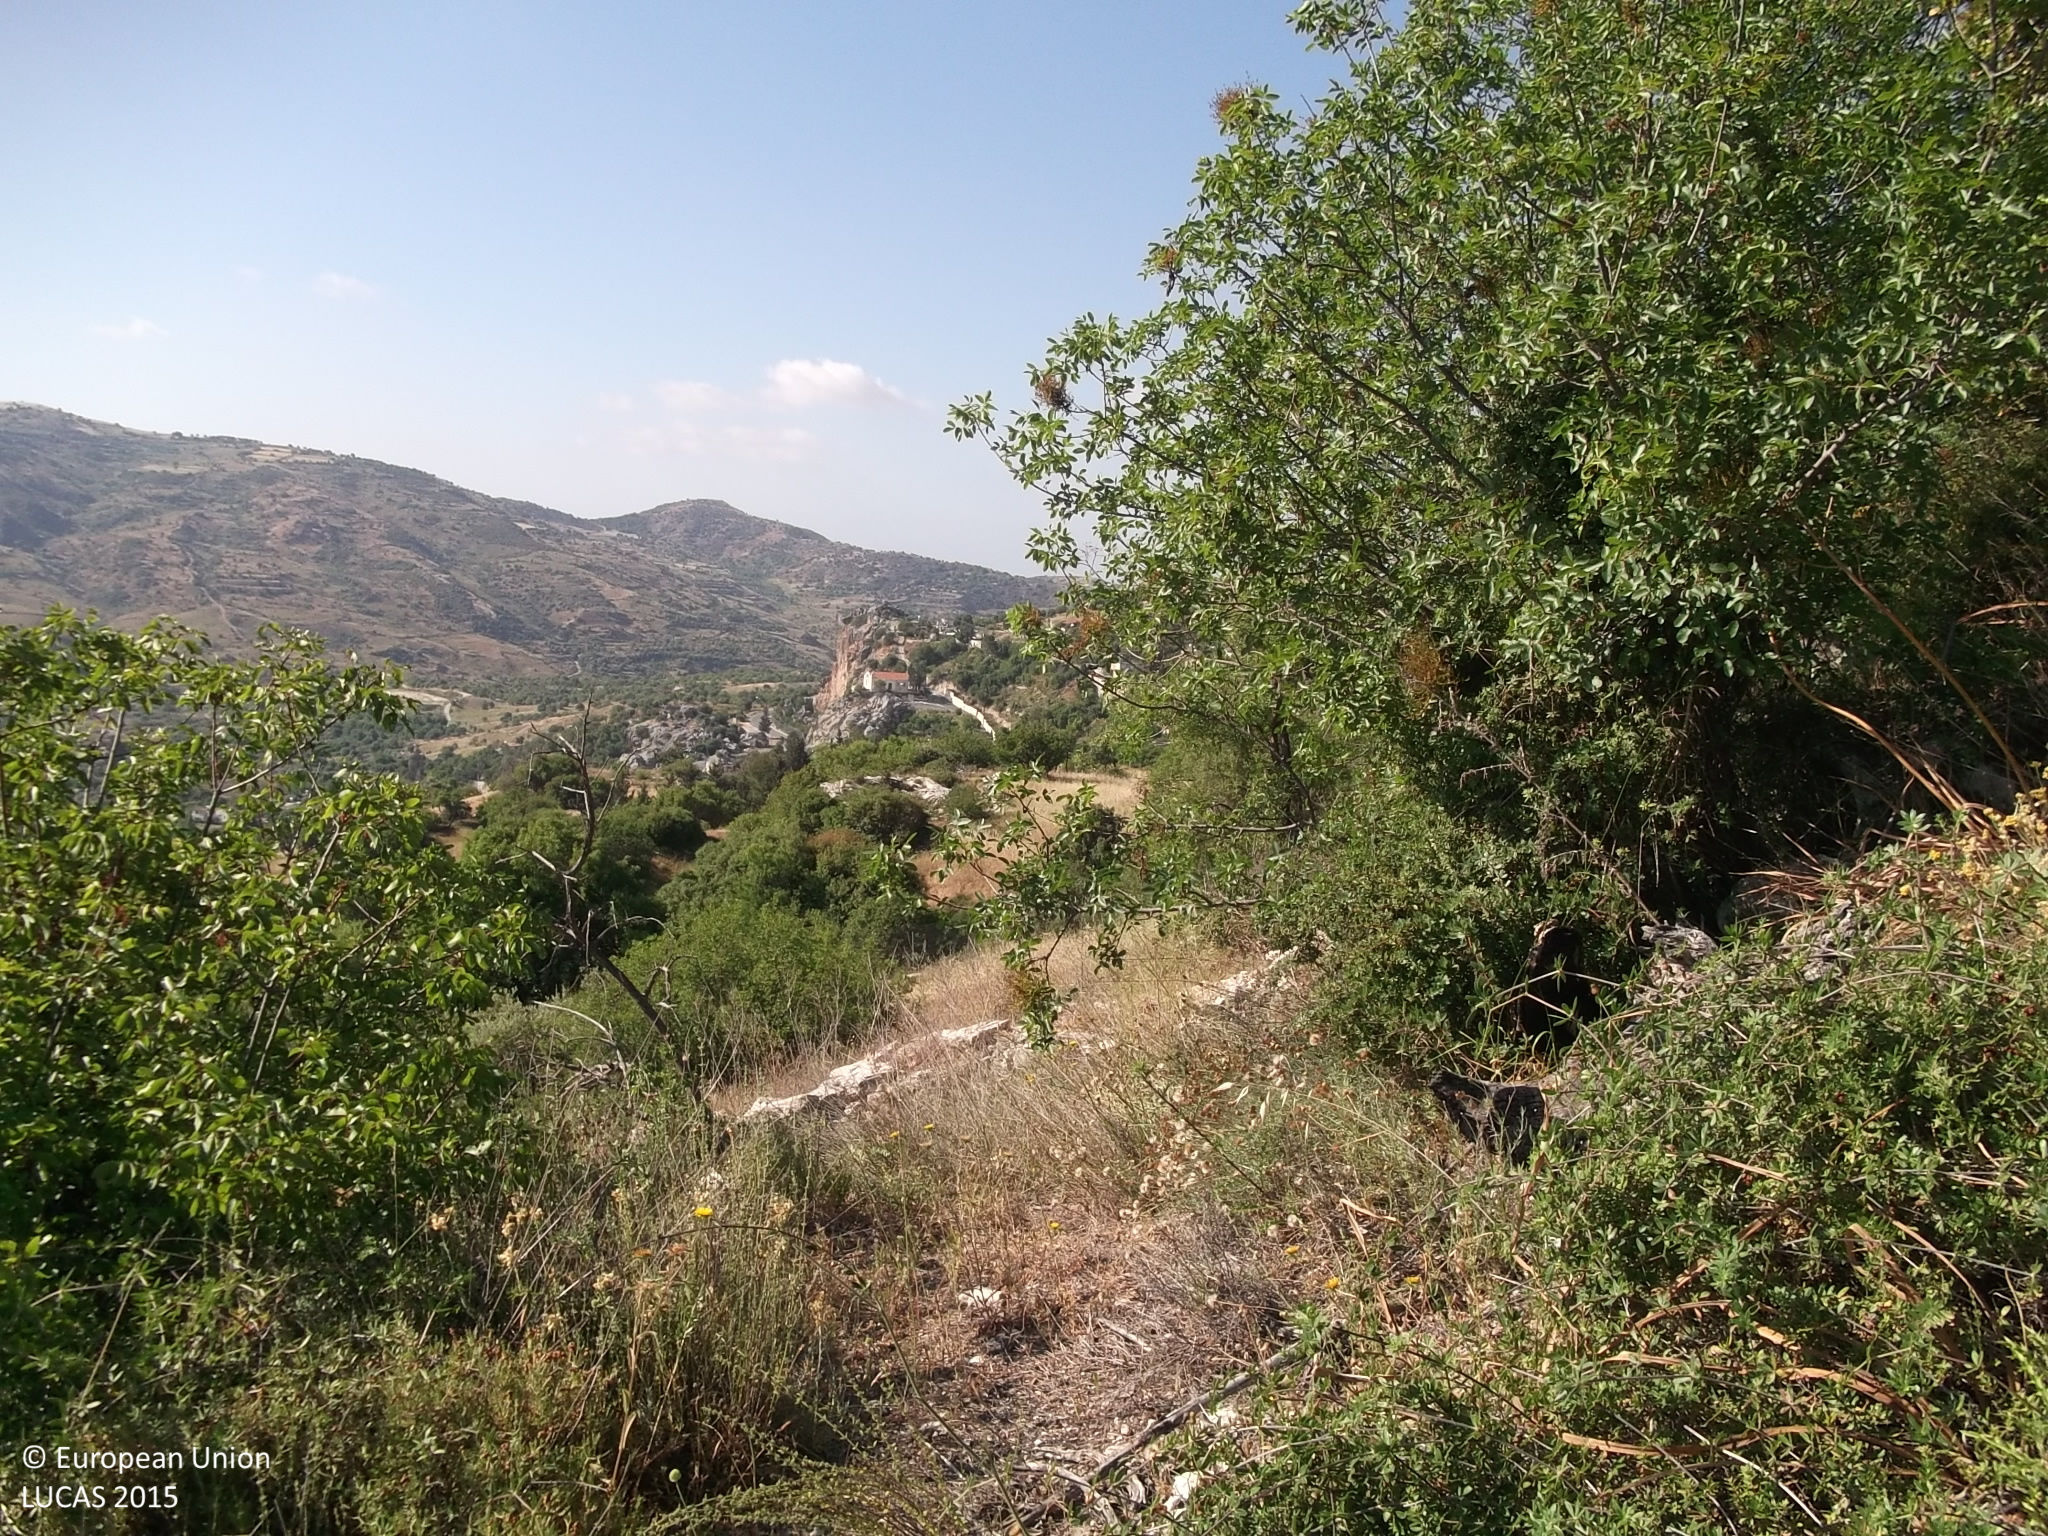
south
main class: Shrubland
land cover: Shrubland with sparse tree cover
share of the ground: 50 - 75 %
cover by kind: shrubs 70 %, herbaceous plants 15 %, unconsolidated bare surface 10 %, broadleaved forest trees 5 %
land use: Semi-natural and natural areas not in use
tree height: < 5 m
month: May
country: CY
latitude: 34.8019
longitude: 32.5240
